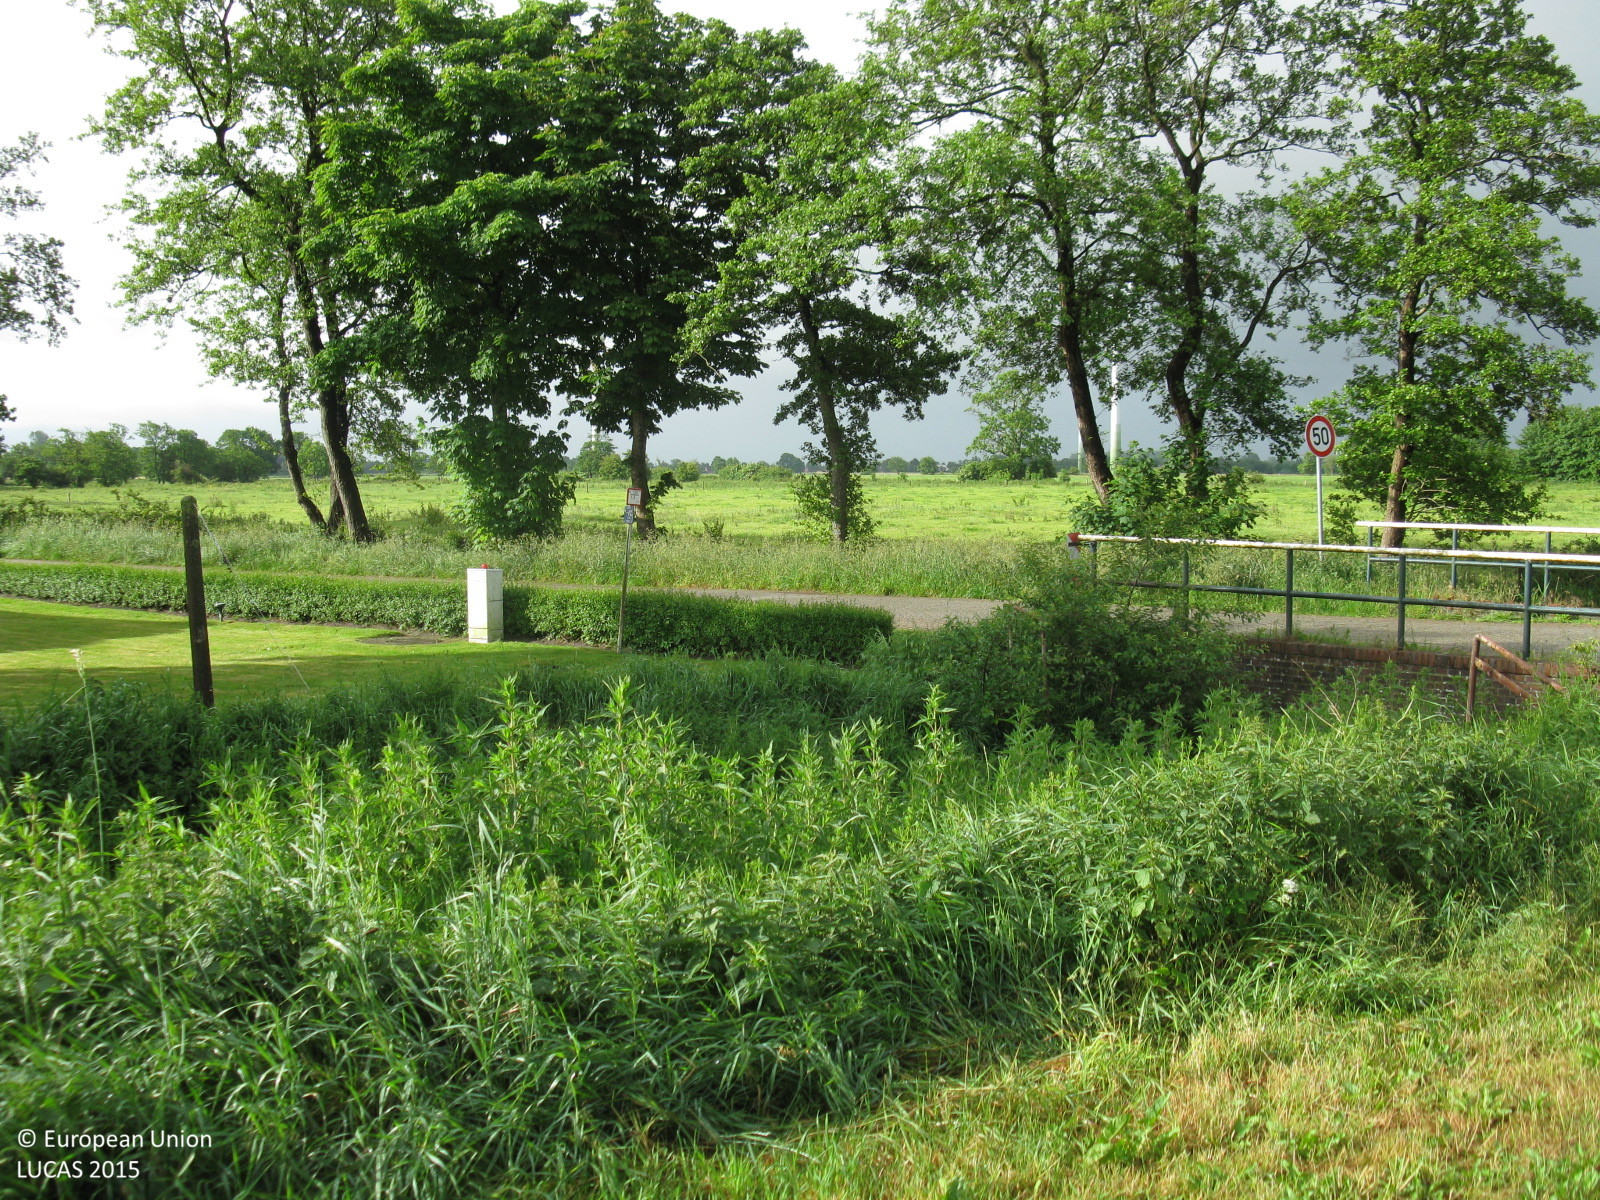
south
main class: Grassland
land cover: Grassland without tree/shrub cover
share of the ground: > 75 %
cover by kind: herbaceous plants 100 %
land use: Agriculture (excluding fallow land and kitchen gardens)
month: June
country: DE
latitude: 53.4985
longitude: 7.3324
